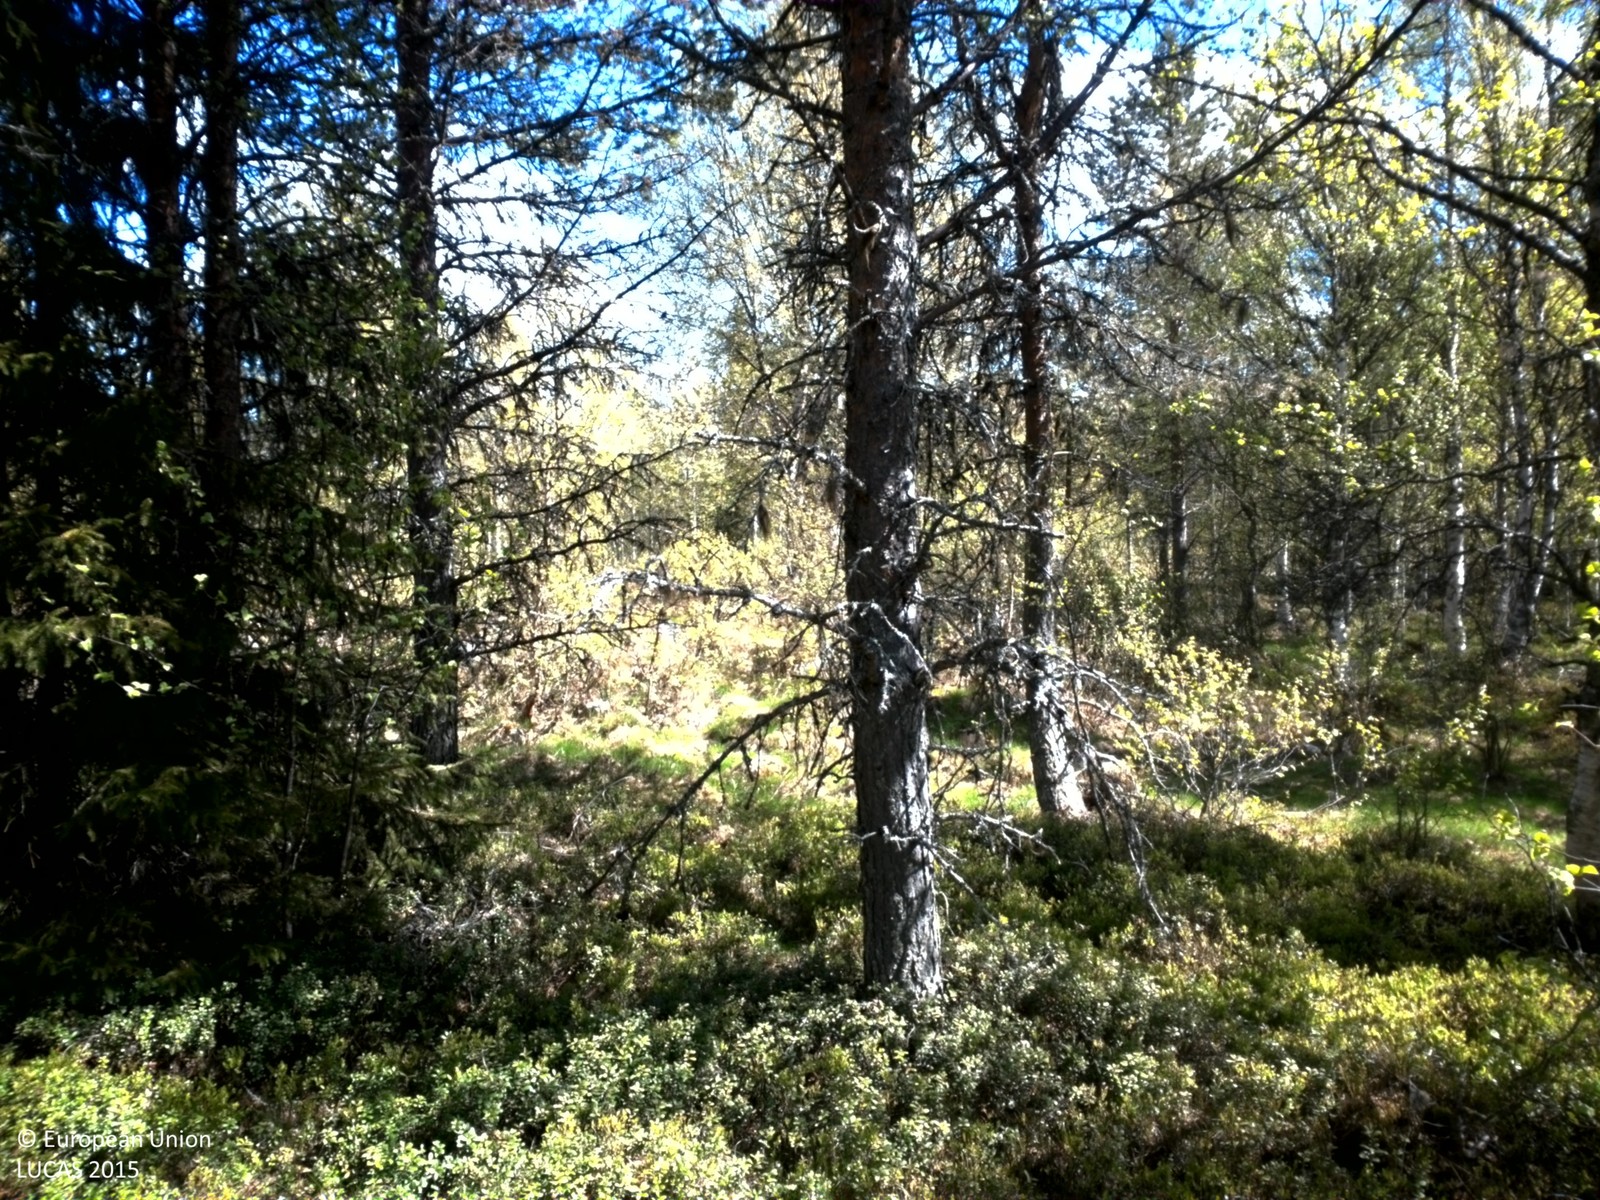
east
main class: Woodland
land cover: Pine dominated mixed woodland
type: boreal forest
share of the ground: 25 - 50 %
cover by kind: coniferous forest trees 30 %, herbaceous plants 30 %, broadleaved forest trees 20 %, shrubs 10 %, lichens and mosses 10 %
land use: Forestry
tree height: > 5 m
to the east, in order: Pine dominated mixed woodland; Shrubland with sparse tree cover; Ditches and canals; Paved roads, cycling and walking lanes; Ditches and canals; Broadleaved woodland; Pine dominated mixed woodland
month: June
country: SE
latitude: 64.3543
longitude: 17.3611
